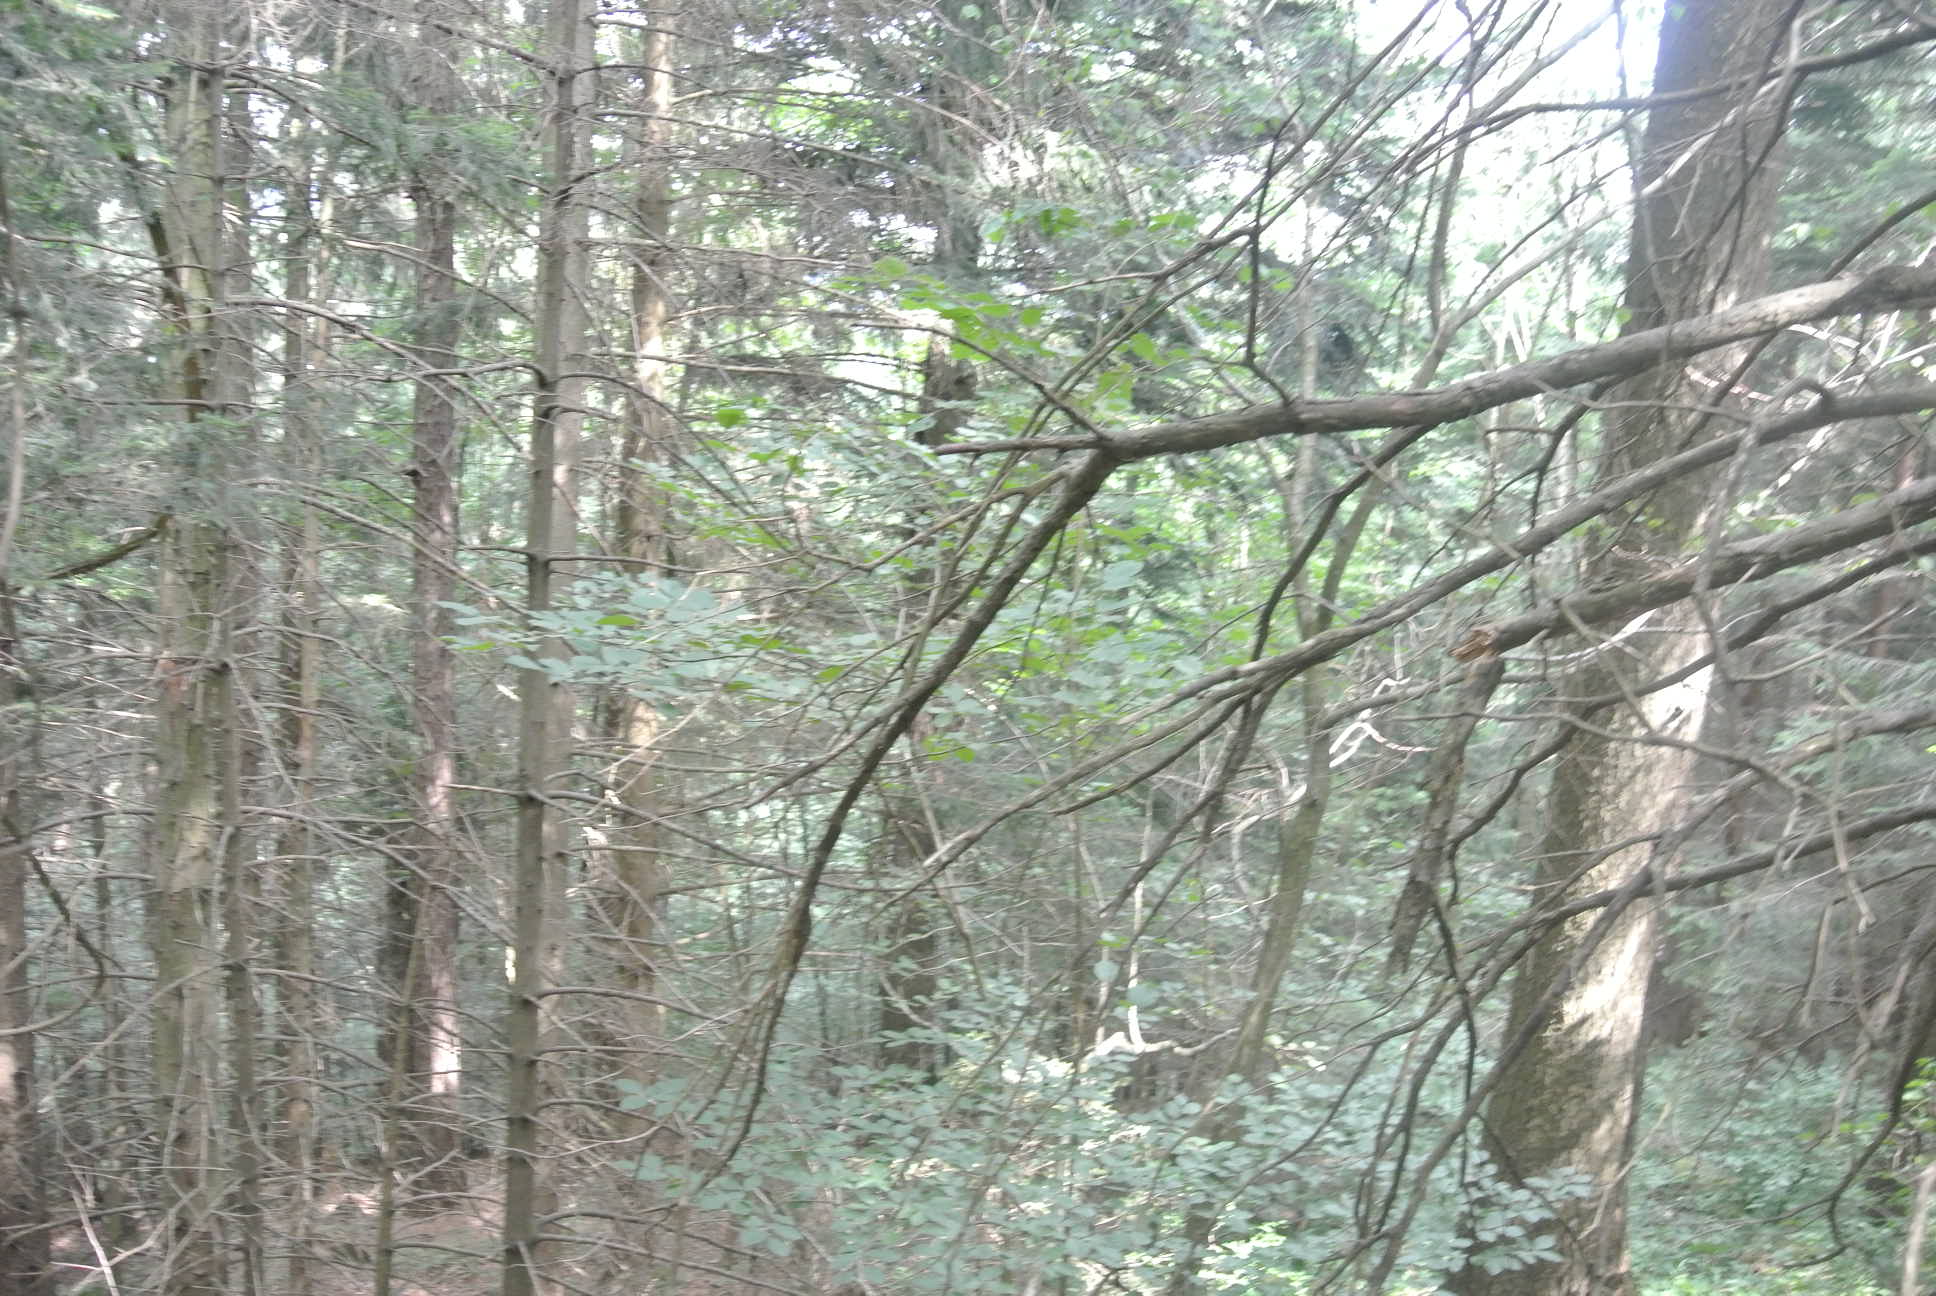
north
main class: Woodland
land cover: Spruce dominated mixed woodland
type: alpine coniferous forest
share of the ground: > 75 %
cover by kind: coniferous forest trees 70 %, broadleaved forest trees 25 %, lichens and mosses 5 %
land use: Forestry
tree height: > 5 m
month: July
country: AT
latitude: 48.0022
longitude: 15.3763
